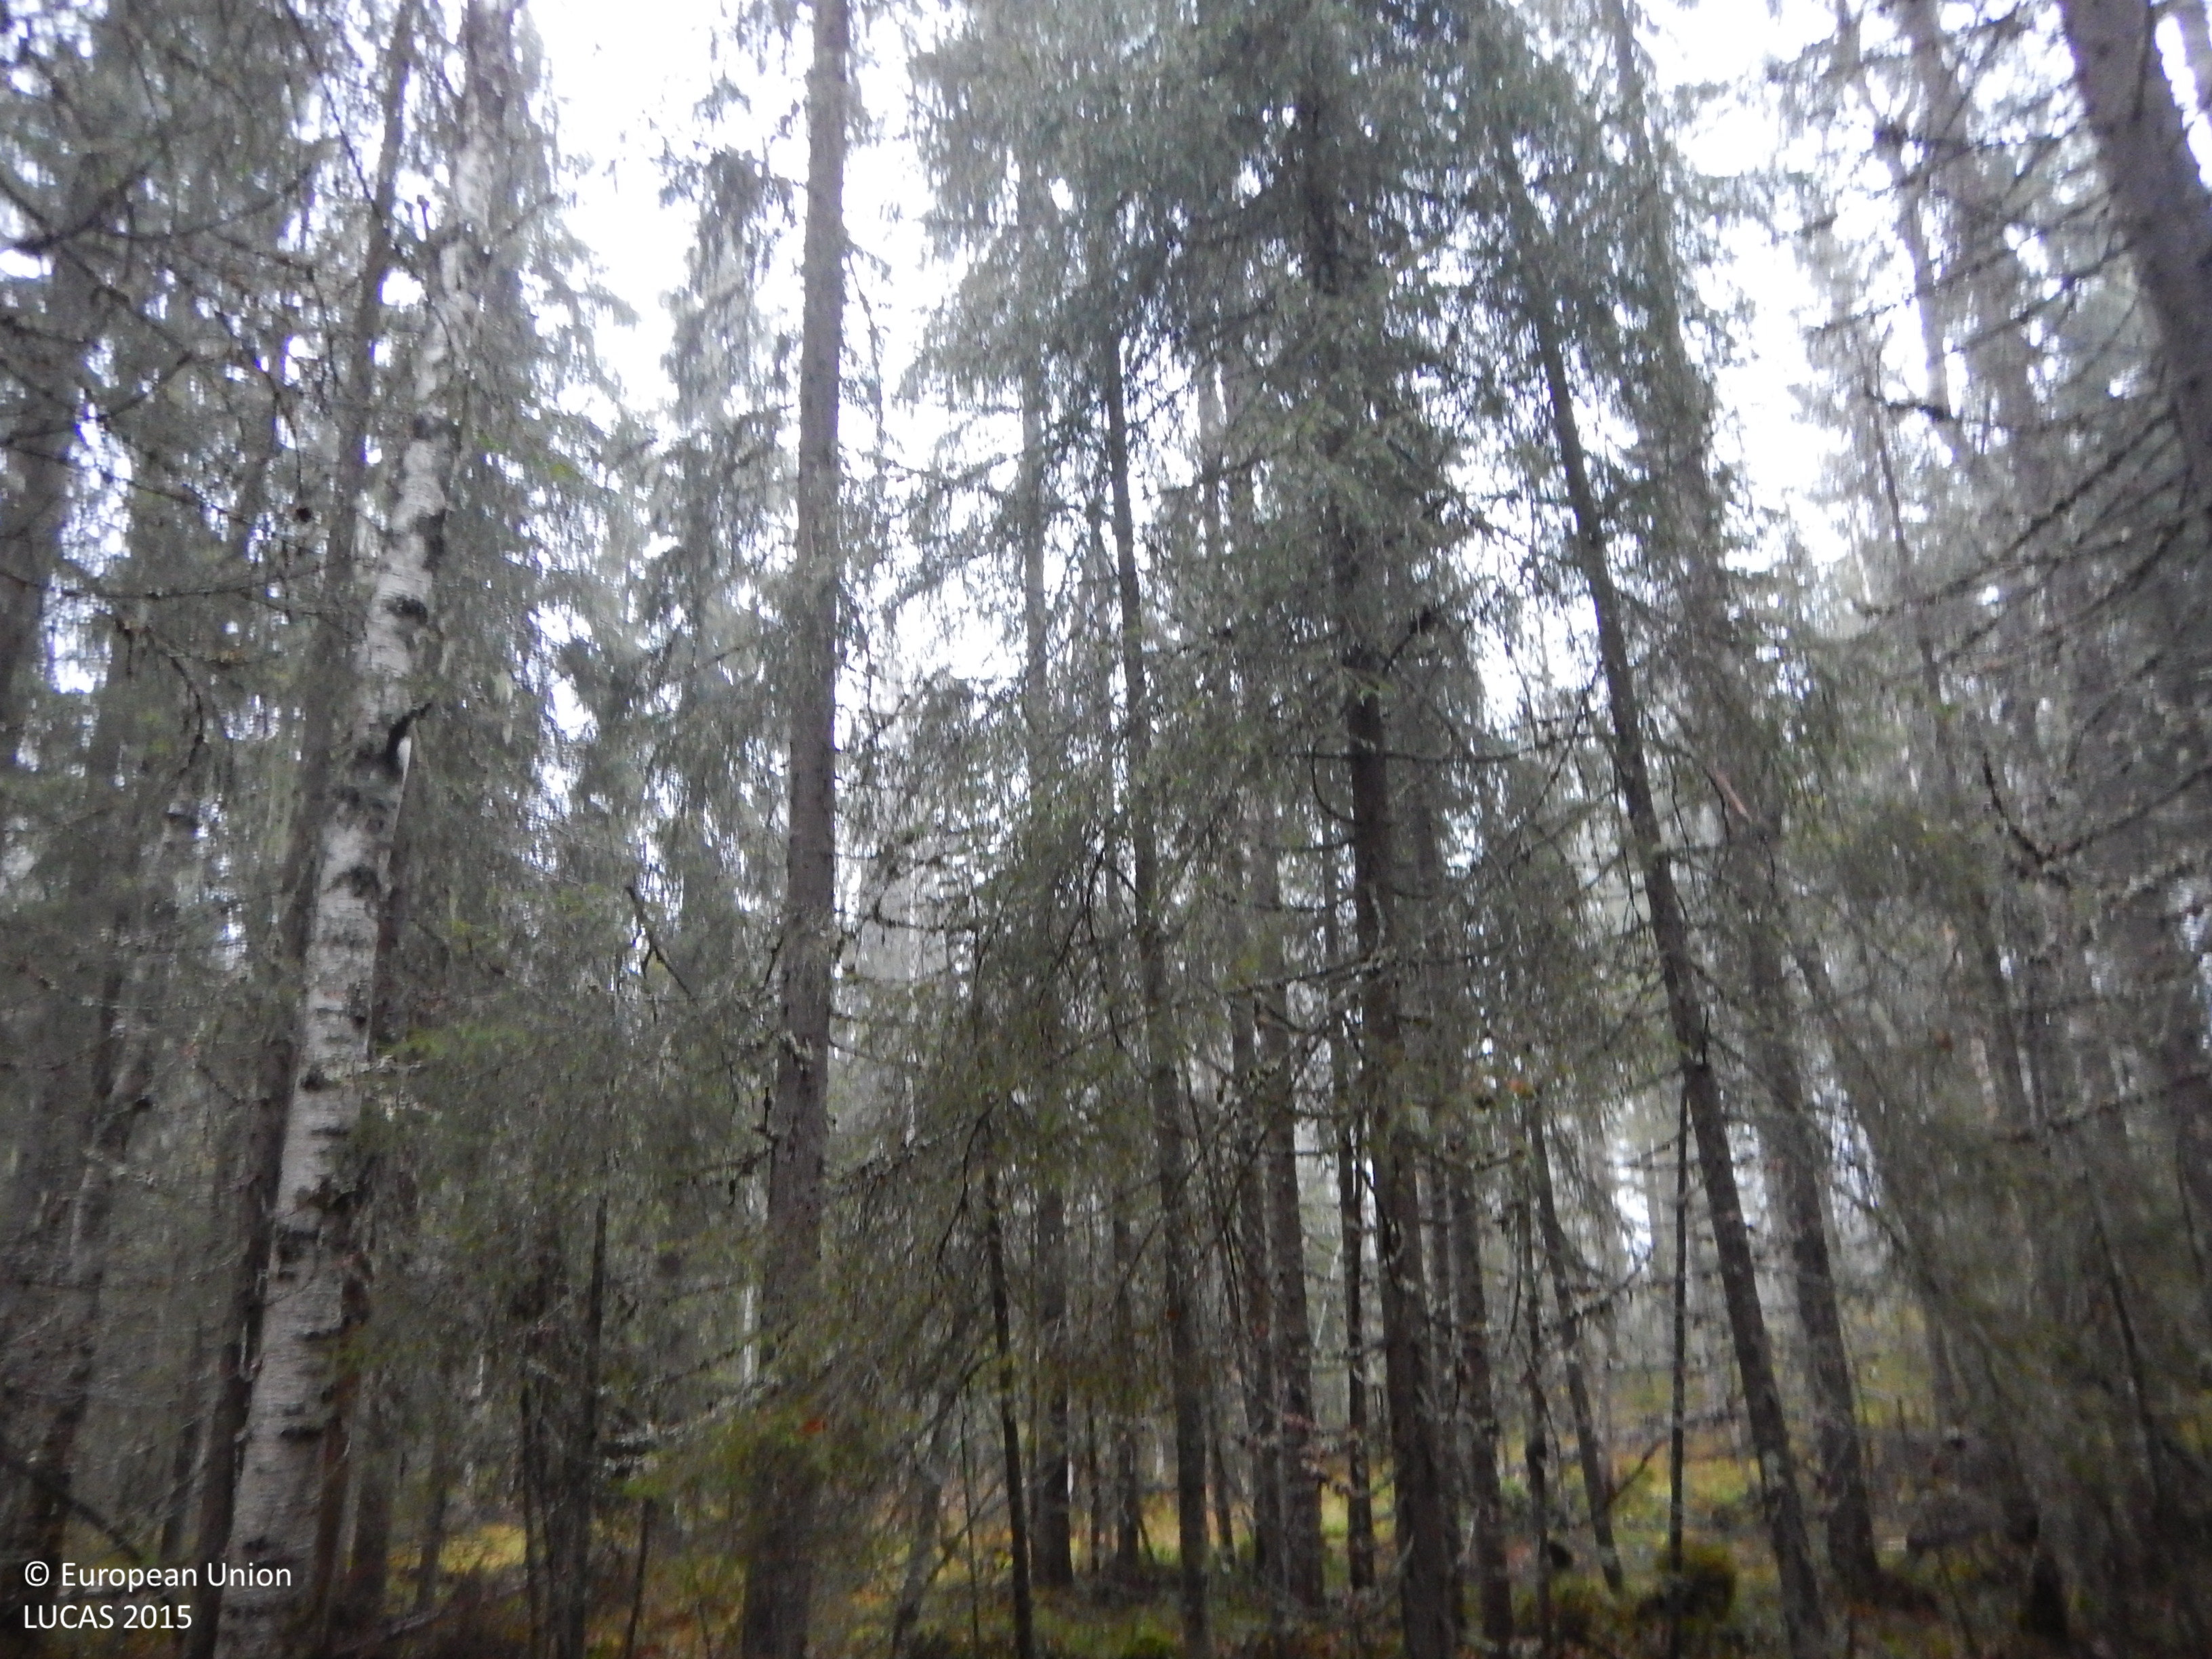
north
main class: Woodland
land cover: Spruce dominated mixed woodland
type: boreal forest
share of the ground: > 75 %
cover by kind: coniferous forest trees 60 %, broadleaved forest trees 20 %, shrubs 10 %, herbaceous plants 5 %, lichens and mosses 5 %
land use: Forestry
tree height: > 5 m
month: November
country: SE
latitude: 65.1402
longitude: 20.5665
